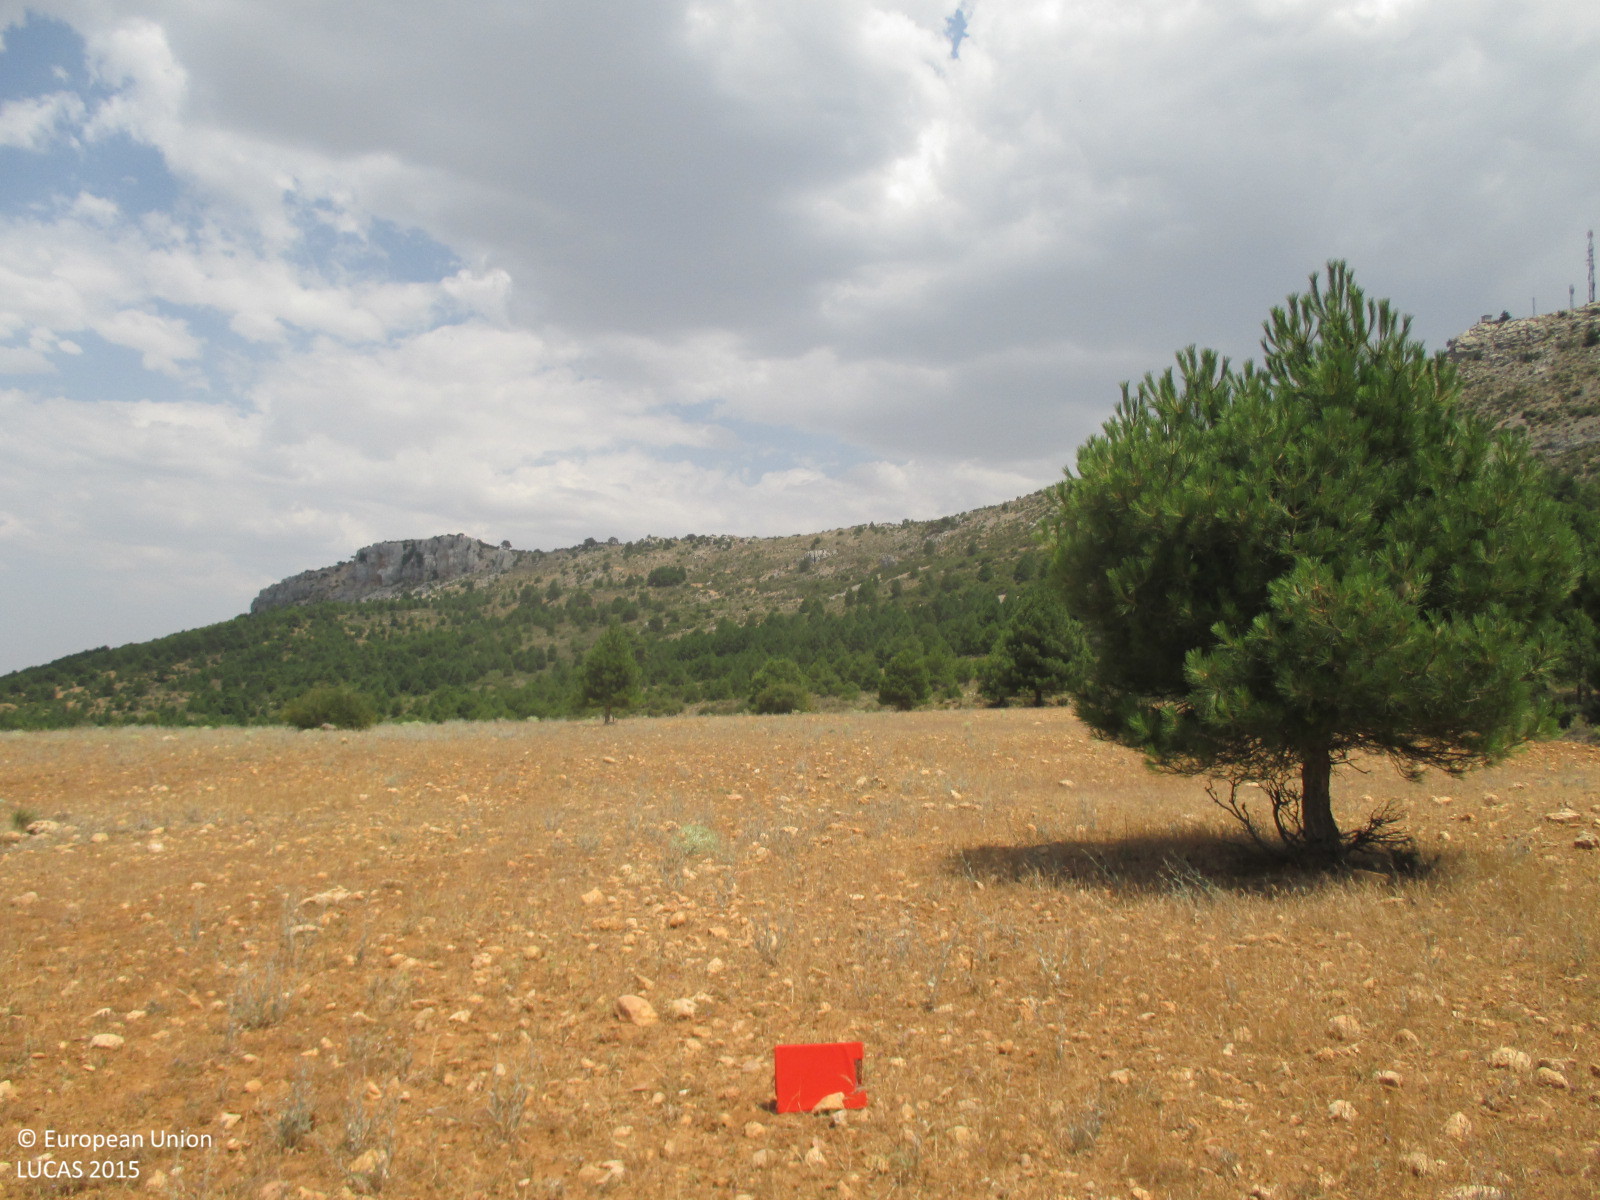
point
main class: Grassland
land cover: Grassland with sparse tree/shrub cover
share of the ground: > 75 %
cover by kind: herbaceous plants 90 %, coniferous forest trees 5 %, unconsolidated bare surface 5 %
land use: Agriculture (excluding fallow land and kitchen gardens)
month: July
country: ES
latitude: 38.1688
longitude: -2.3321
